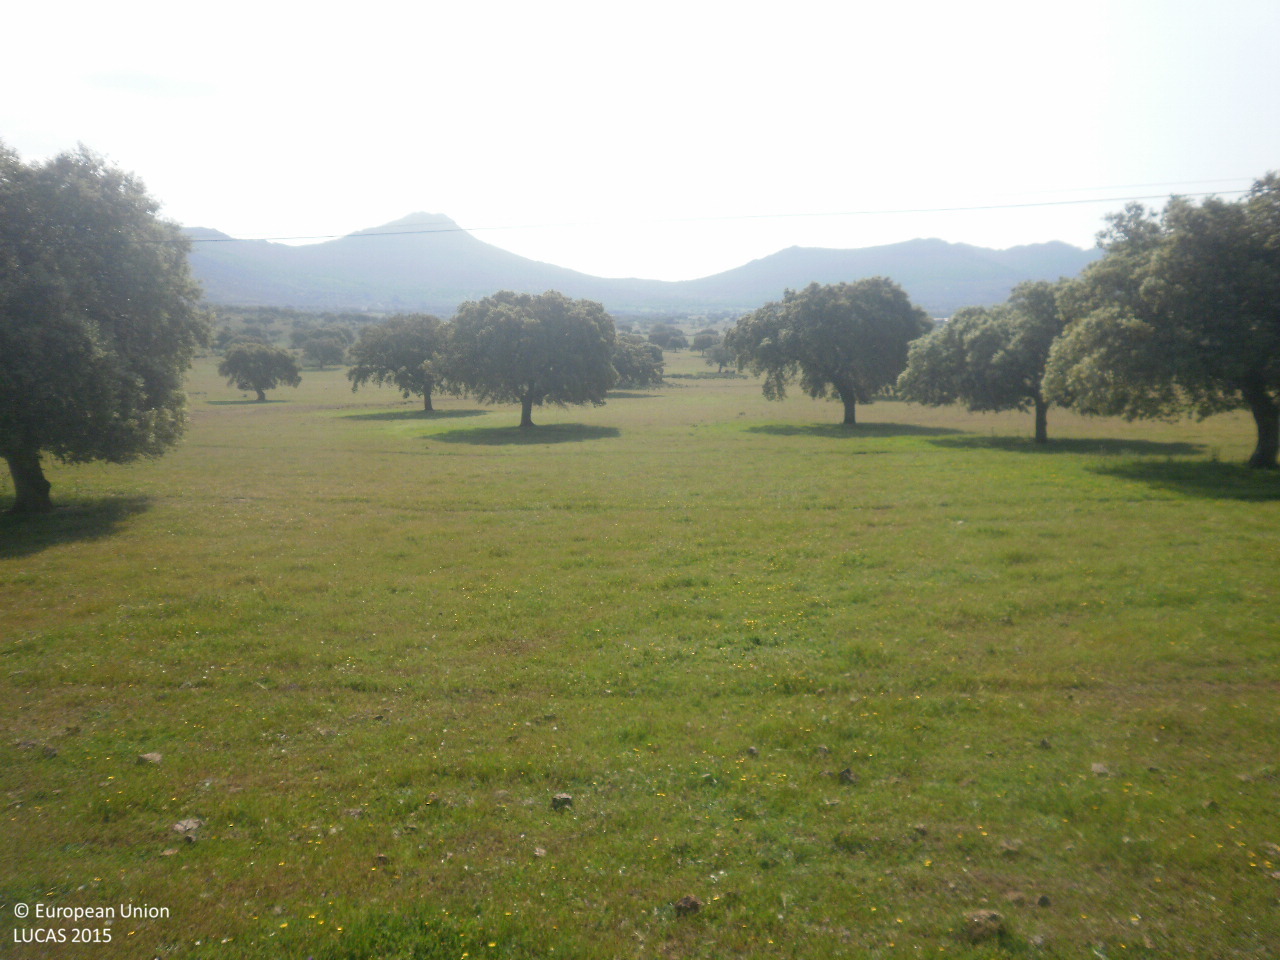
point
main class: Grassland
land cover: Grassland with sparse tree/shrub cover
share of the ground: > 75 %
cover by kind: herbaceous plants 90 %, broadleaved forest trees 5 %, shrubs 5 %
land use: Agriculture (excluding fallow land and kitchen gardens)
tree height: > 5 m
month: April
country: ES
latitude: 38.7641
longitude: -5.1916
